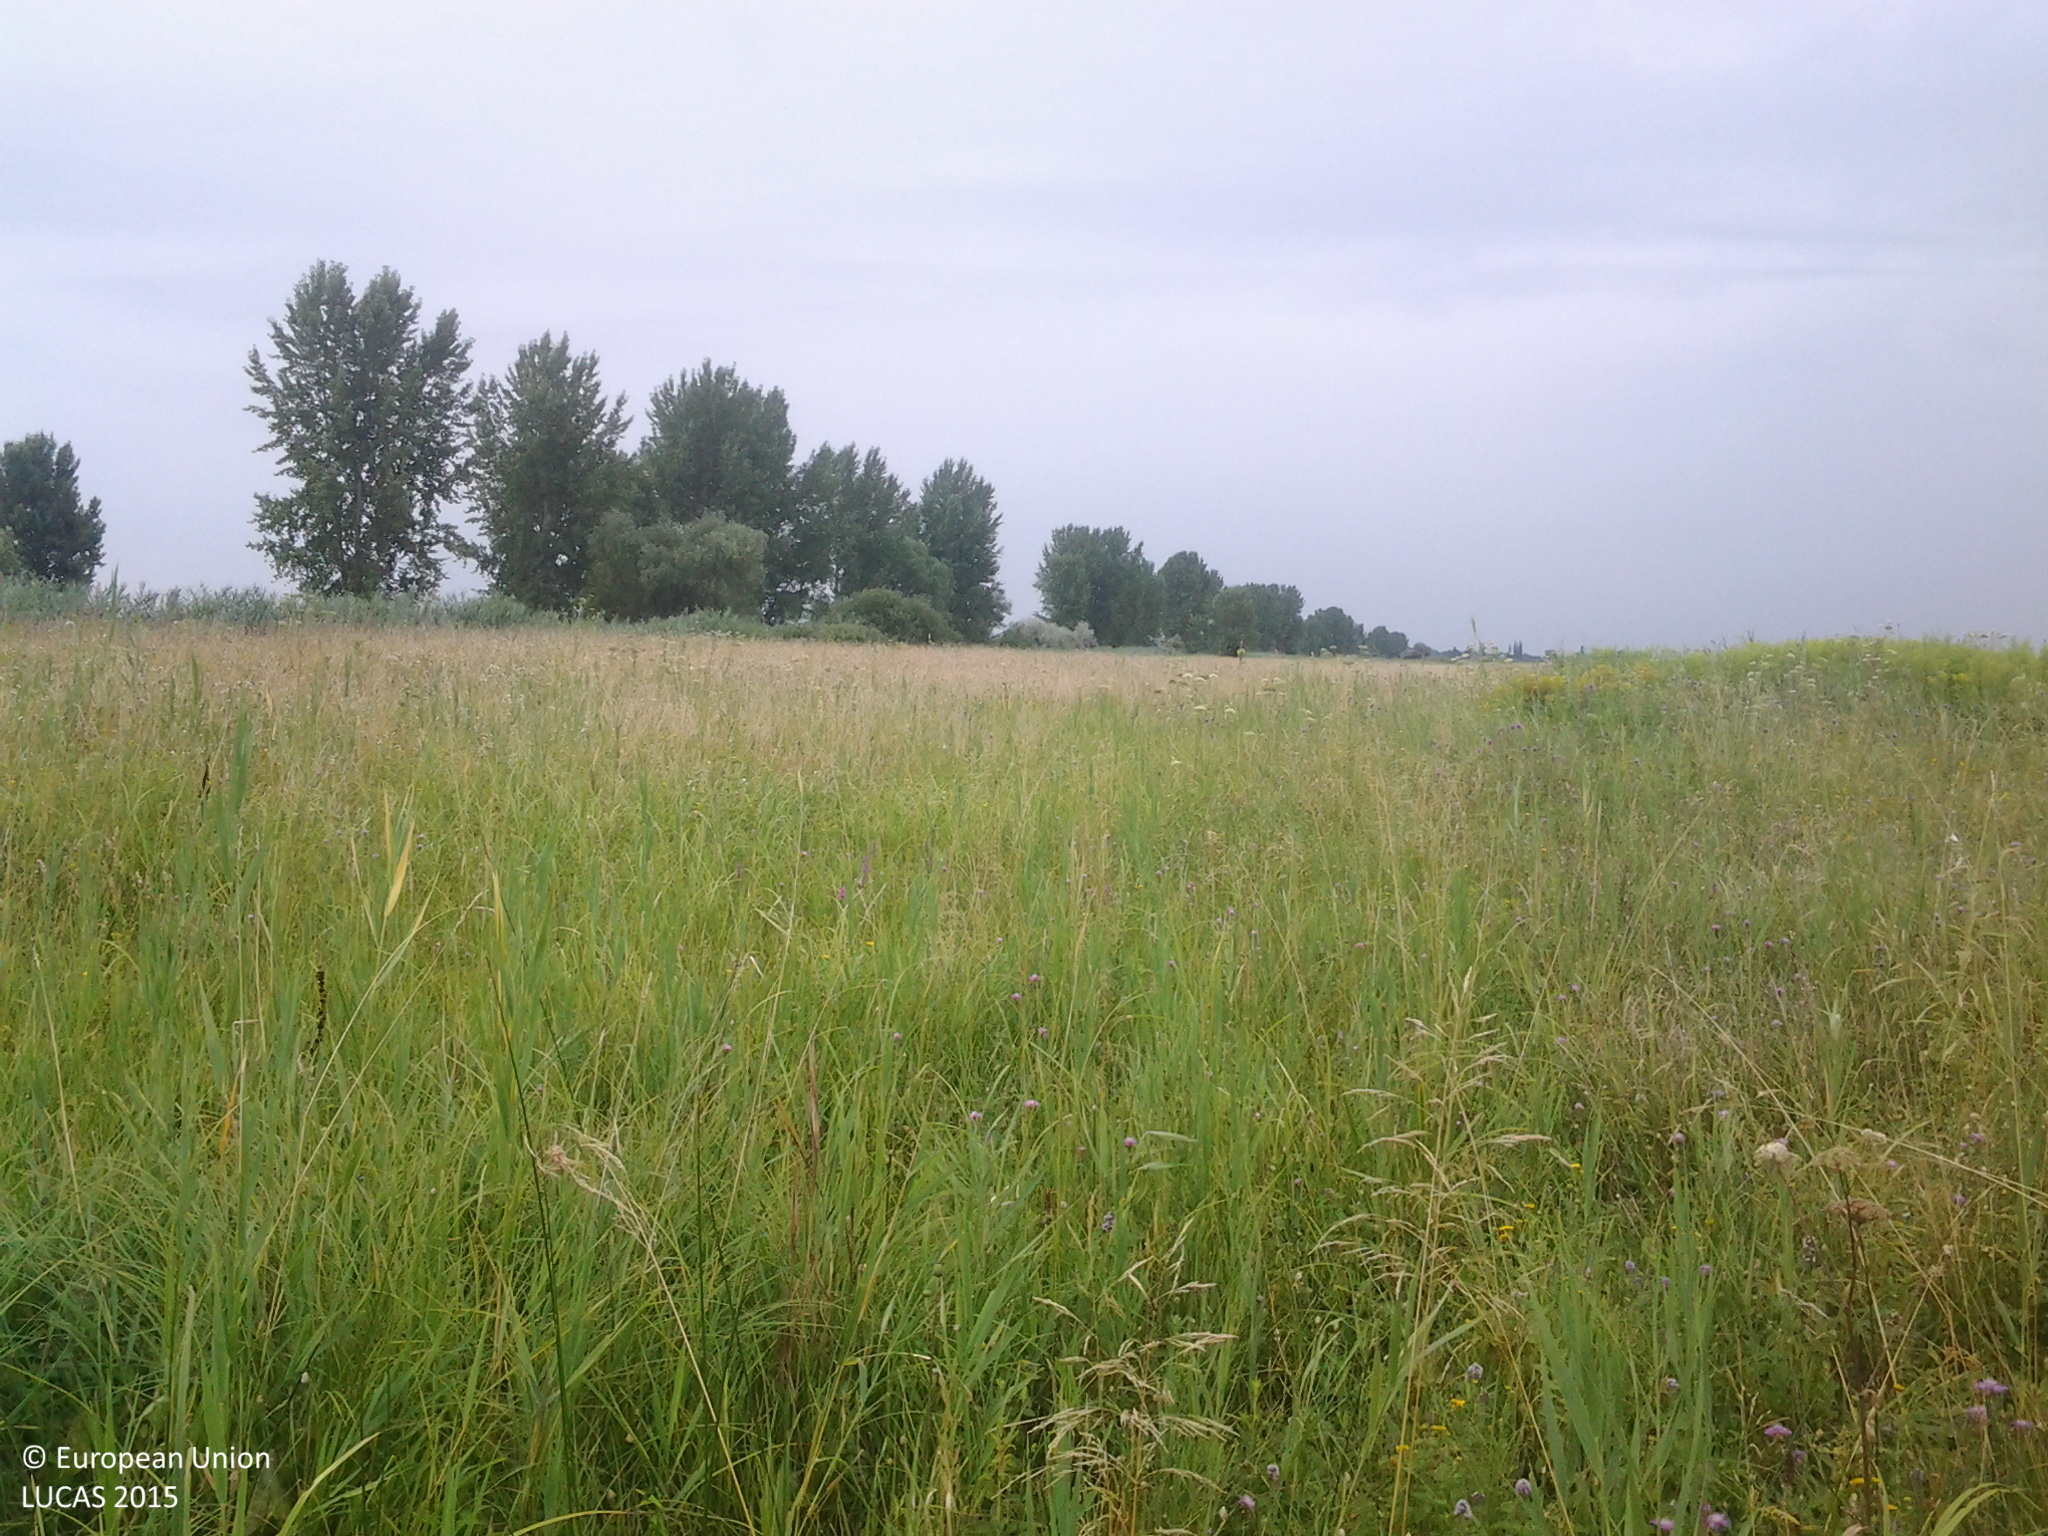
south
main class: Grassland
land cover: Grassland without tree/shrub cover
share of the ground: > 75 %
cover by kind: herbaceous plants 100 %
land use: Agriculture (excluding fallow land and kitchen gardens)
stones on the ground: < 10 %
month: July
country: HU
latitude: 46.6426
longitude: 19.2000
